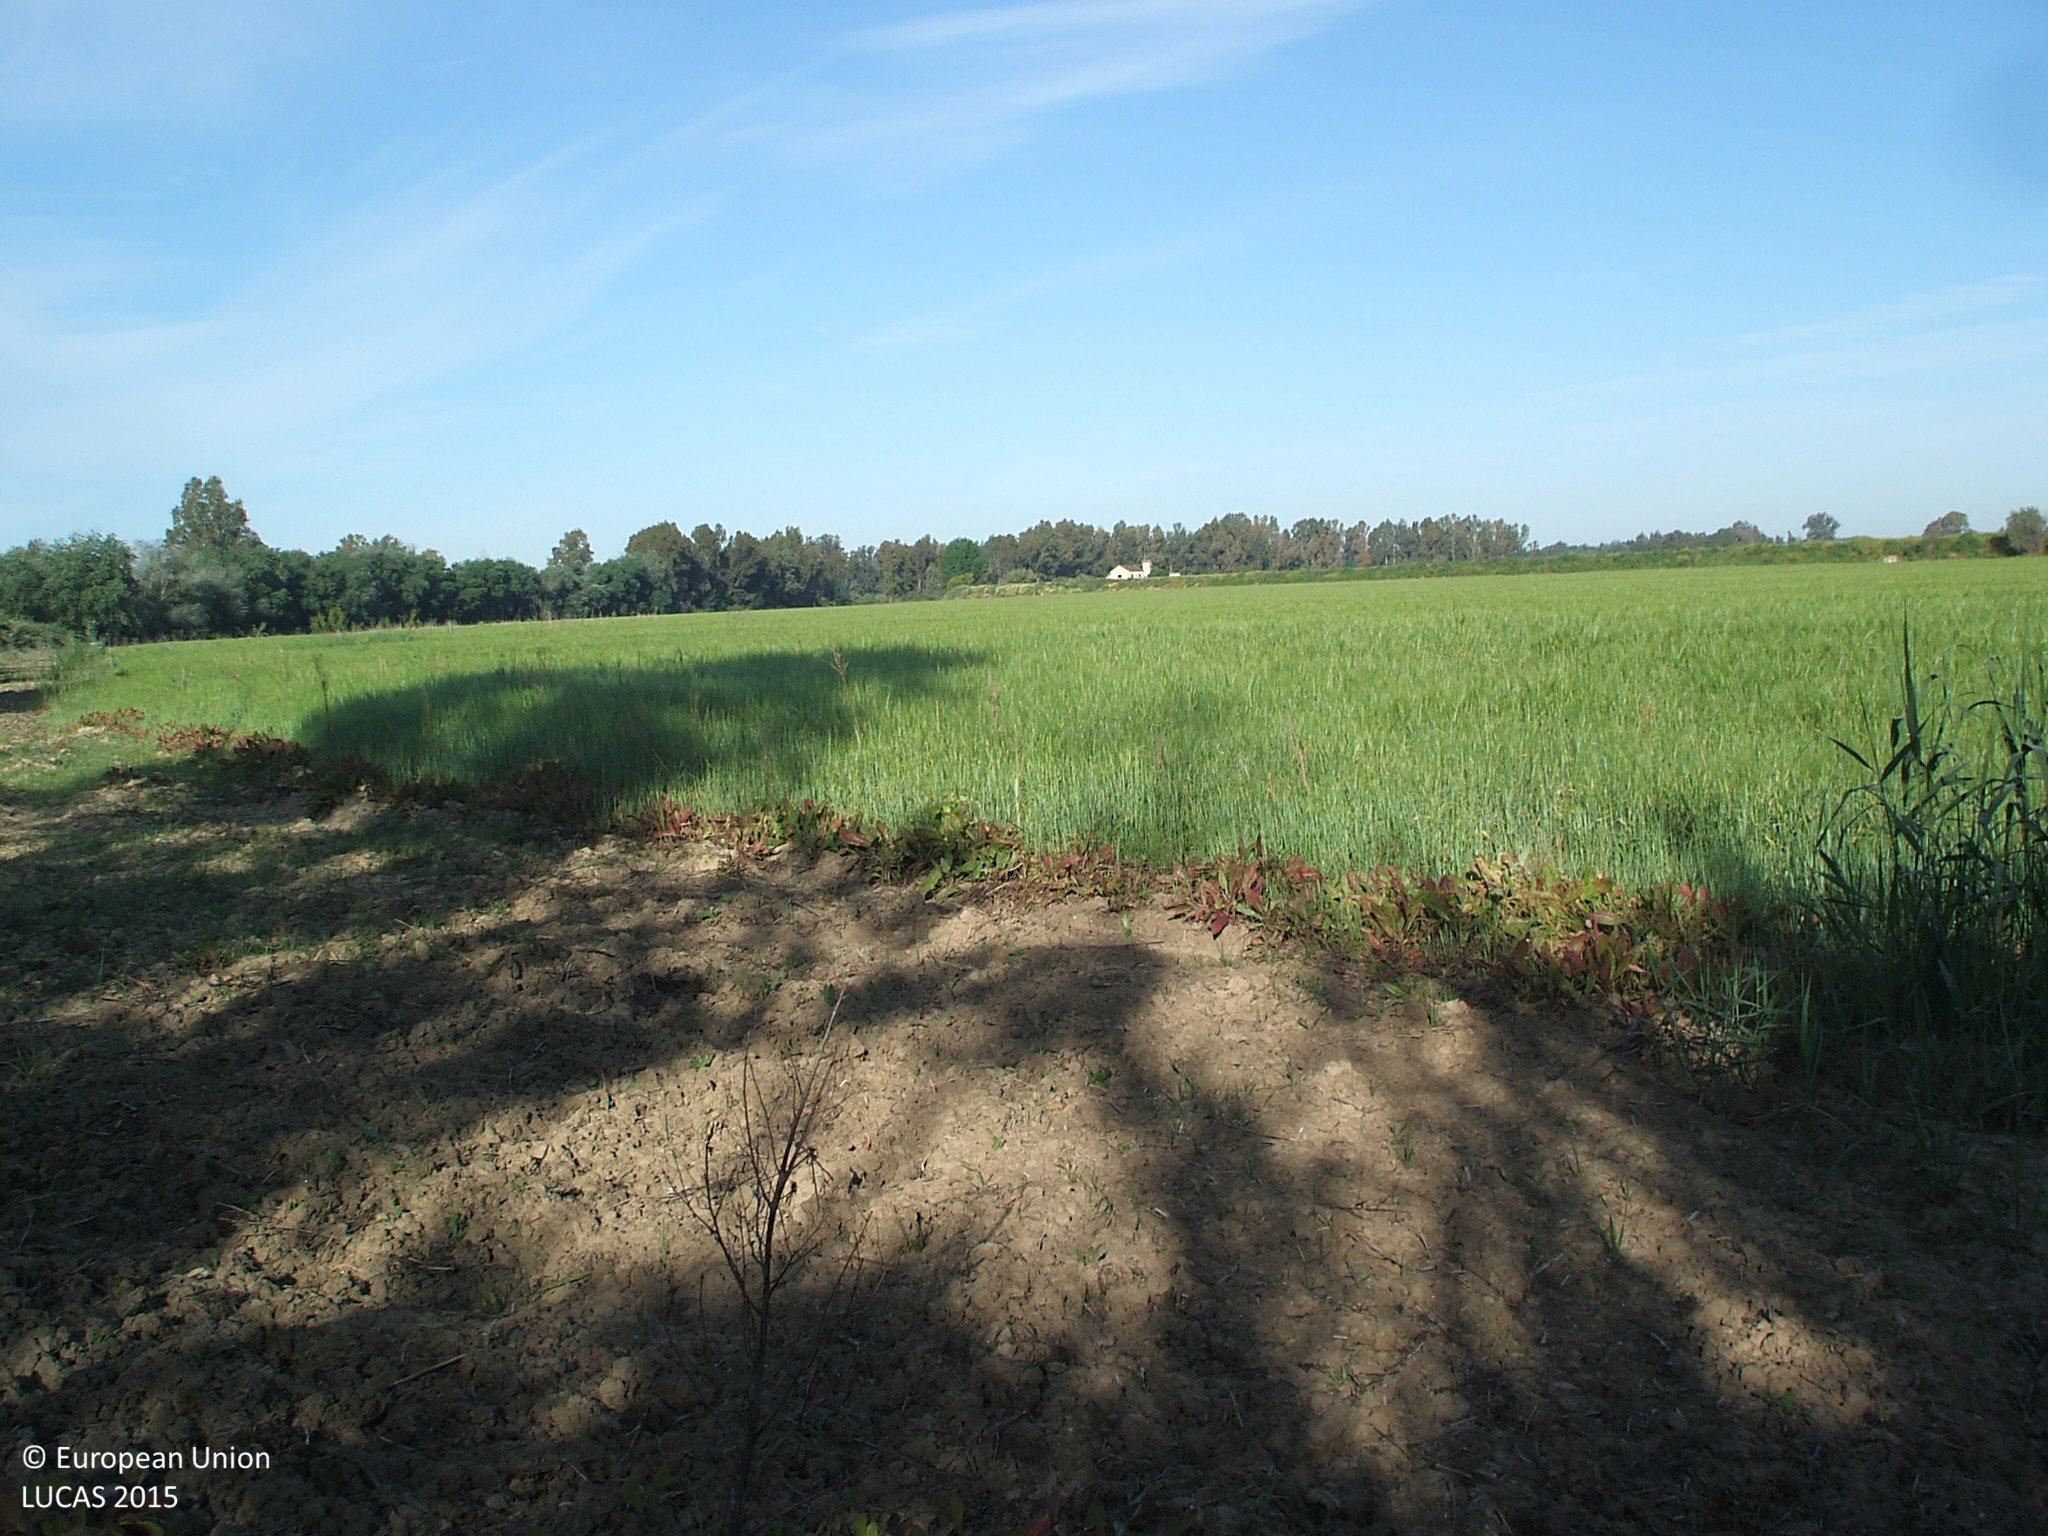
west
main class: Woodland
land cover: Broadleaved woodland
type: exotic forest
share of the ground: 10 - 25 %
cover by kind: shrubs 85 %, broadleaved forest trees 15 %
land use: Semi-natural and natural areas not in use
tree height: > 5 m
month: April
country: ES
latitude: 37.6088
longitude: -5.6205
